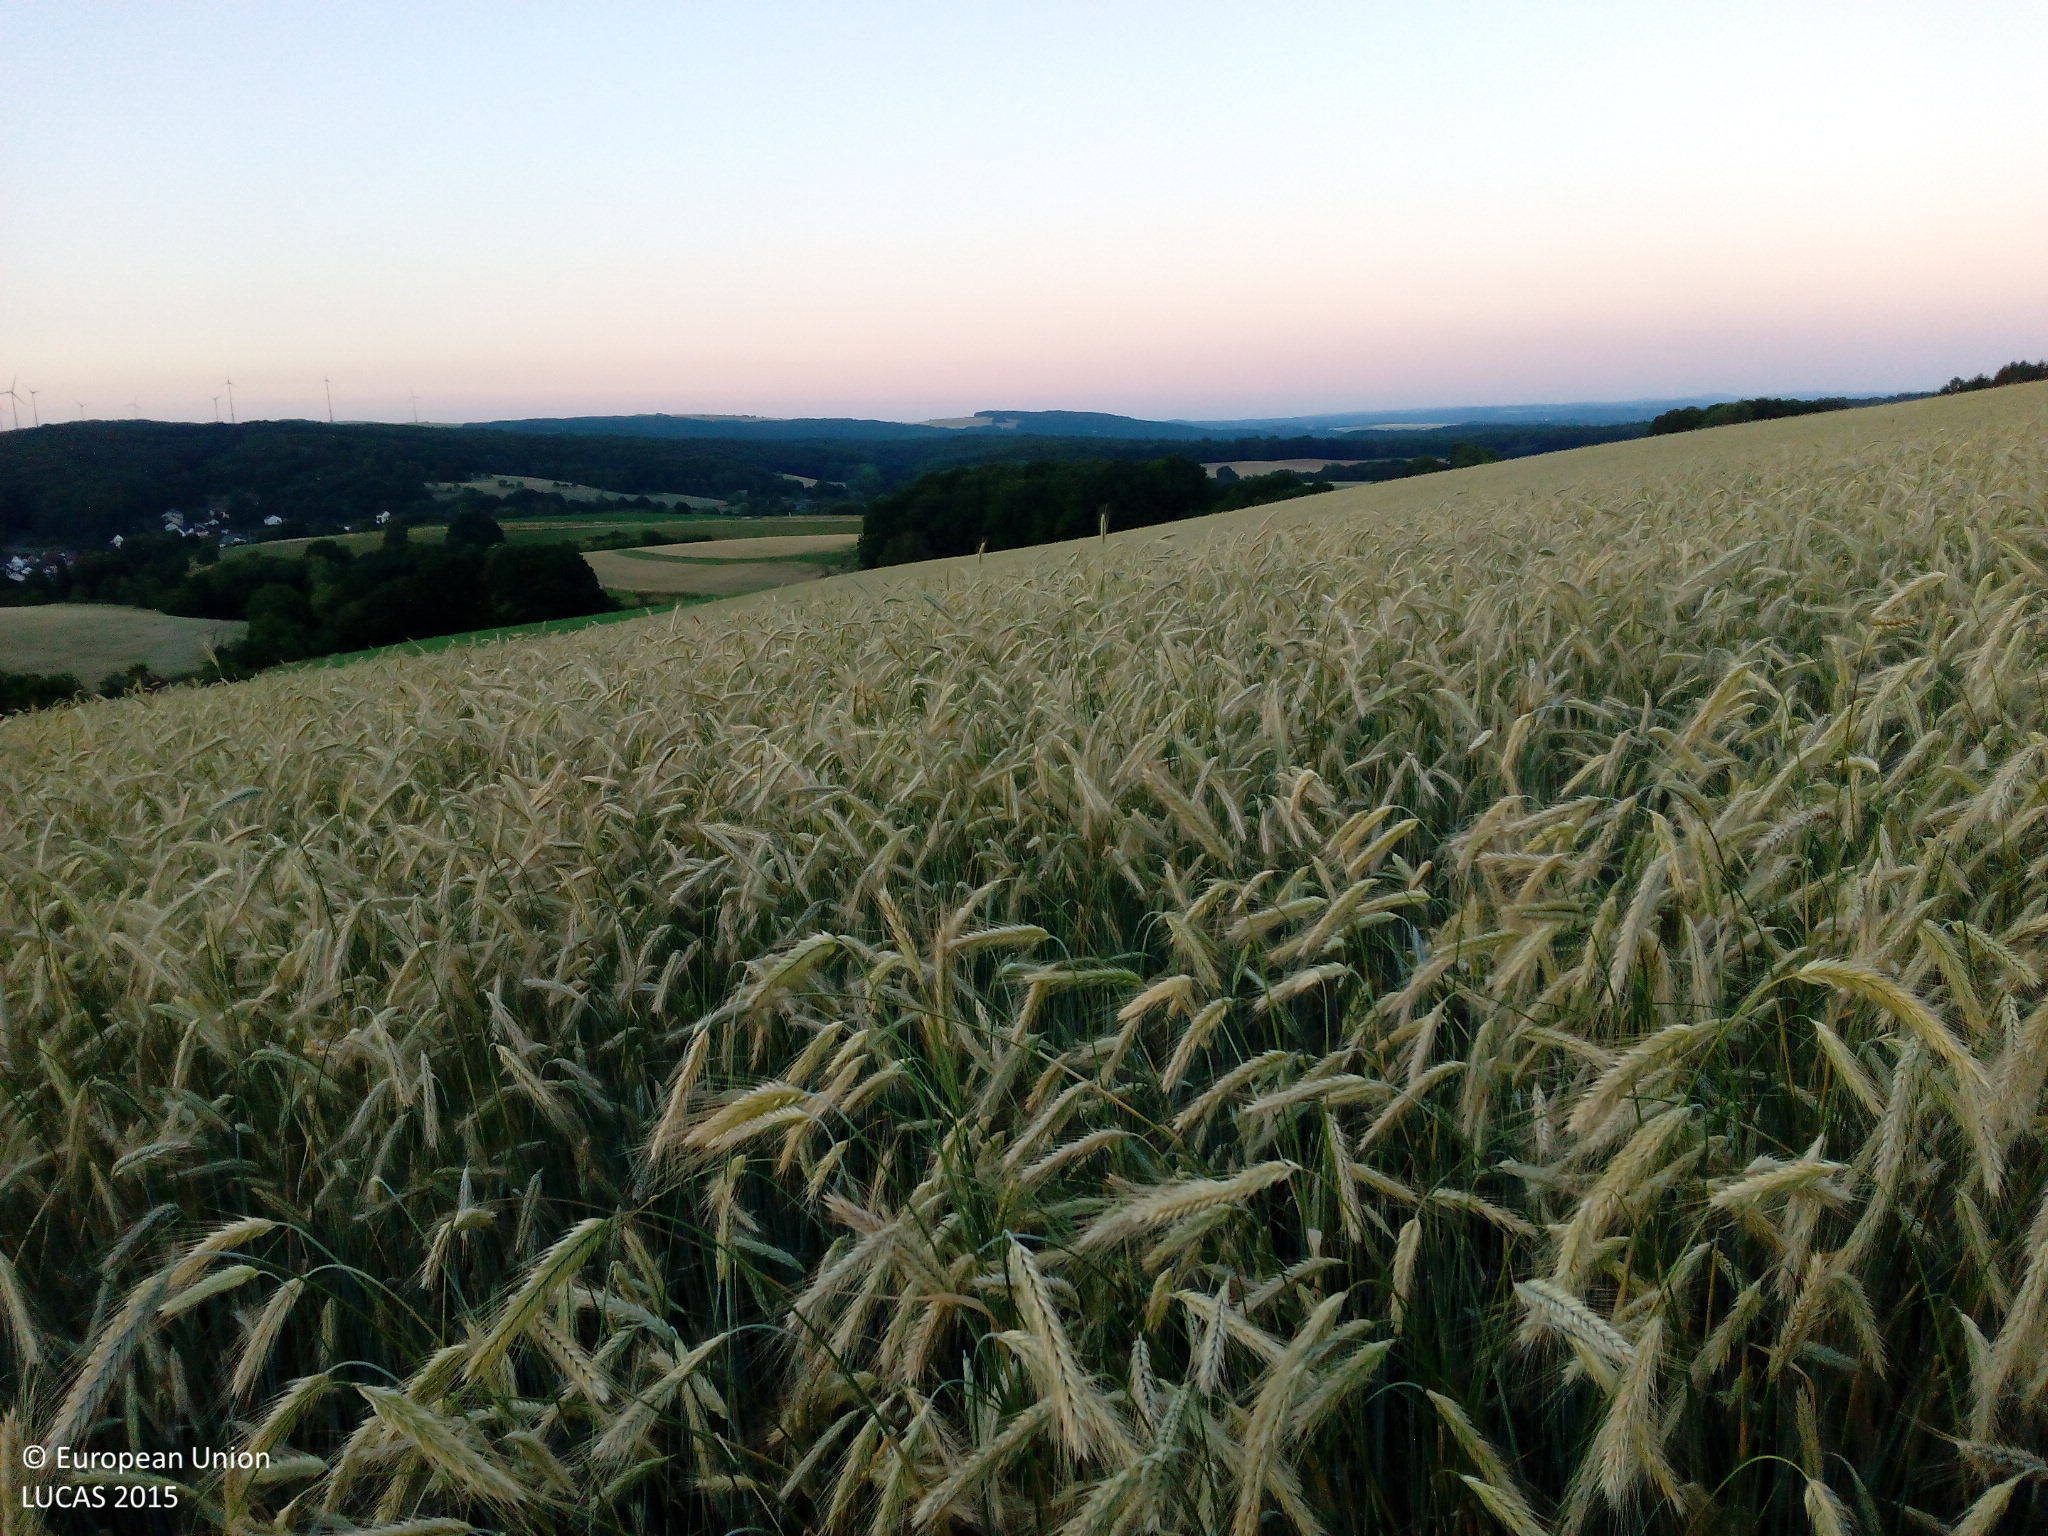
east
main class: Cropland
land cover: Barley
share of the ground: > 75 %
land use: Agriculture (excluding fallow land and kitchen gardens)
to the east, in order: Barley
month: June
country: DE
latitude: 49.4918
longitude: 7.5292
